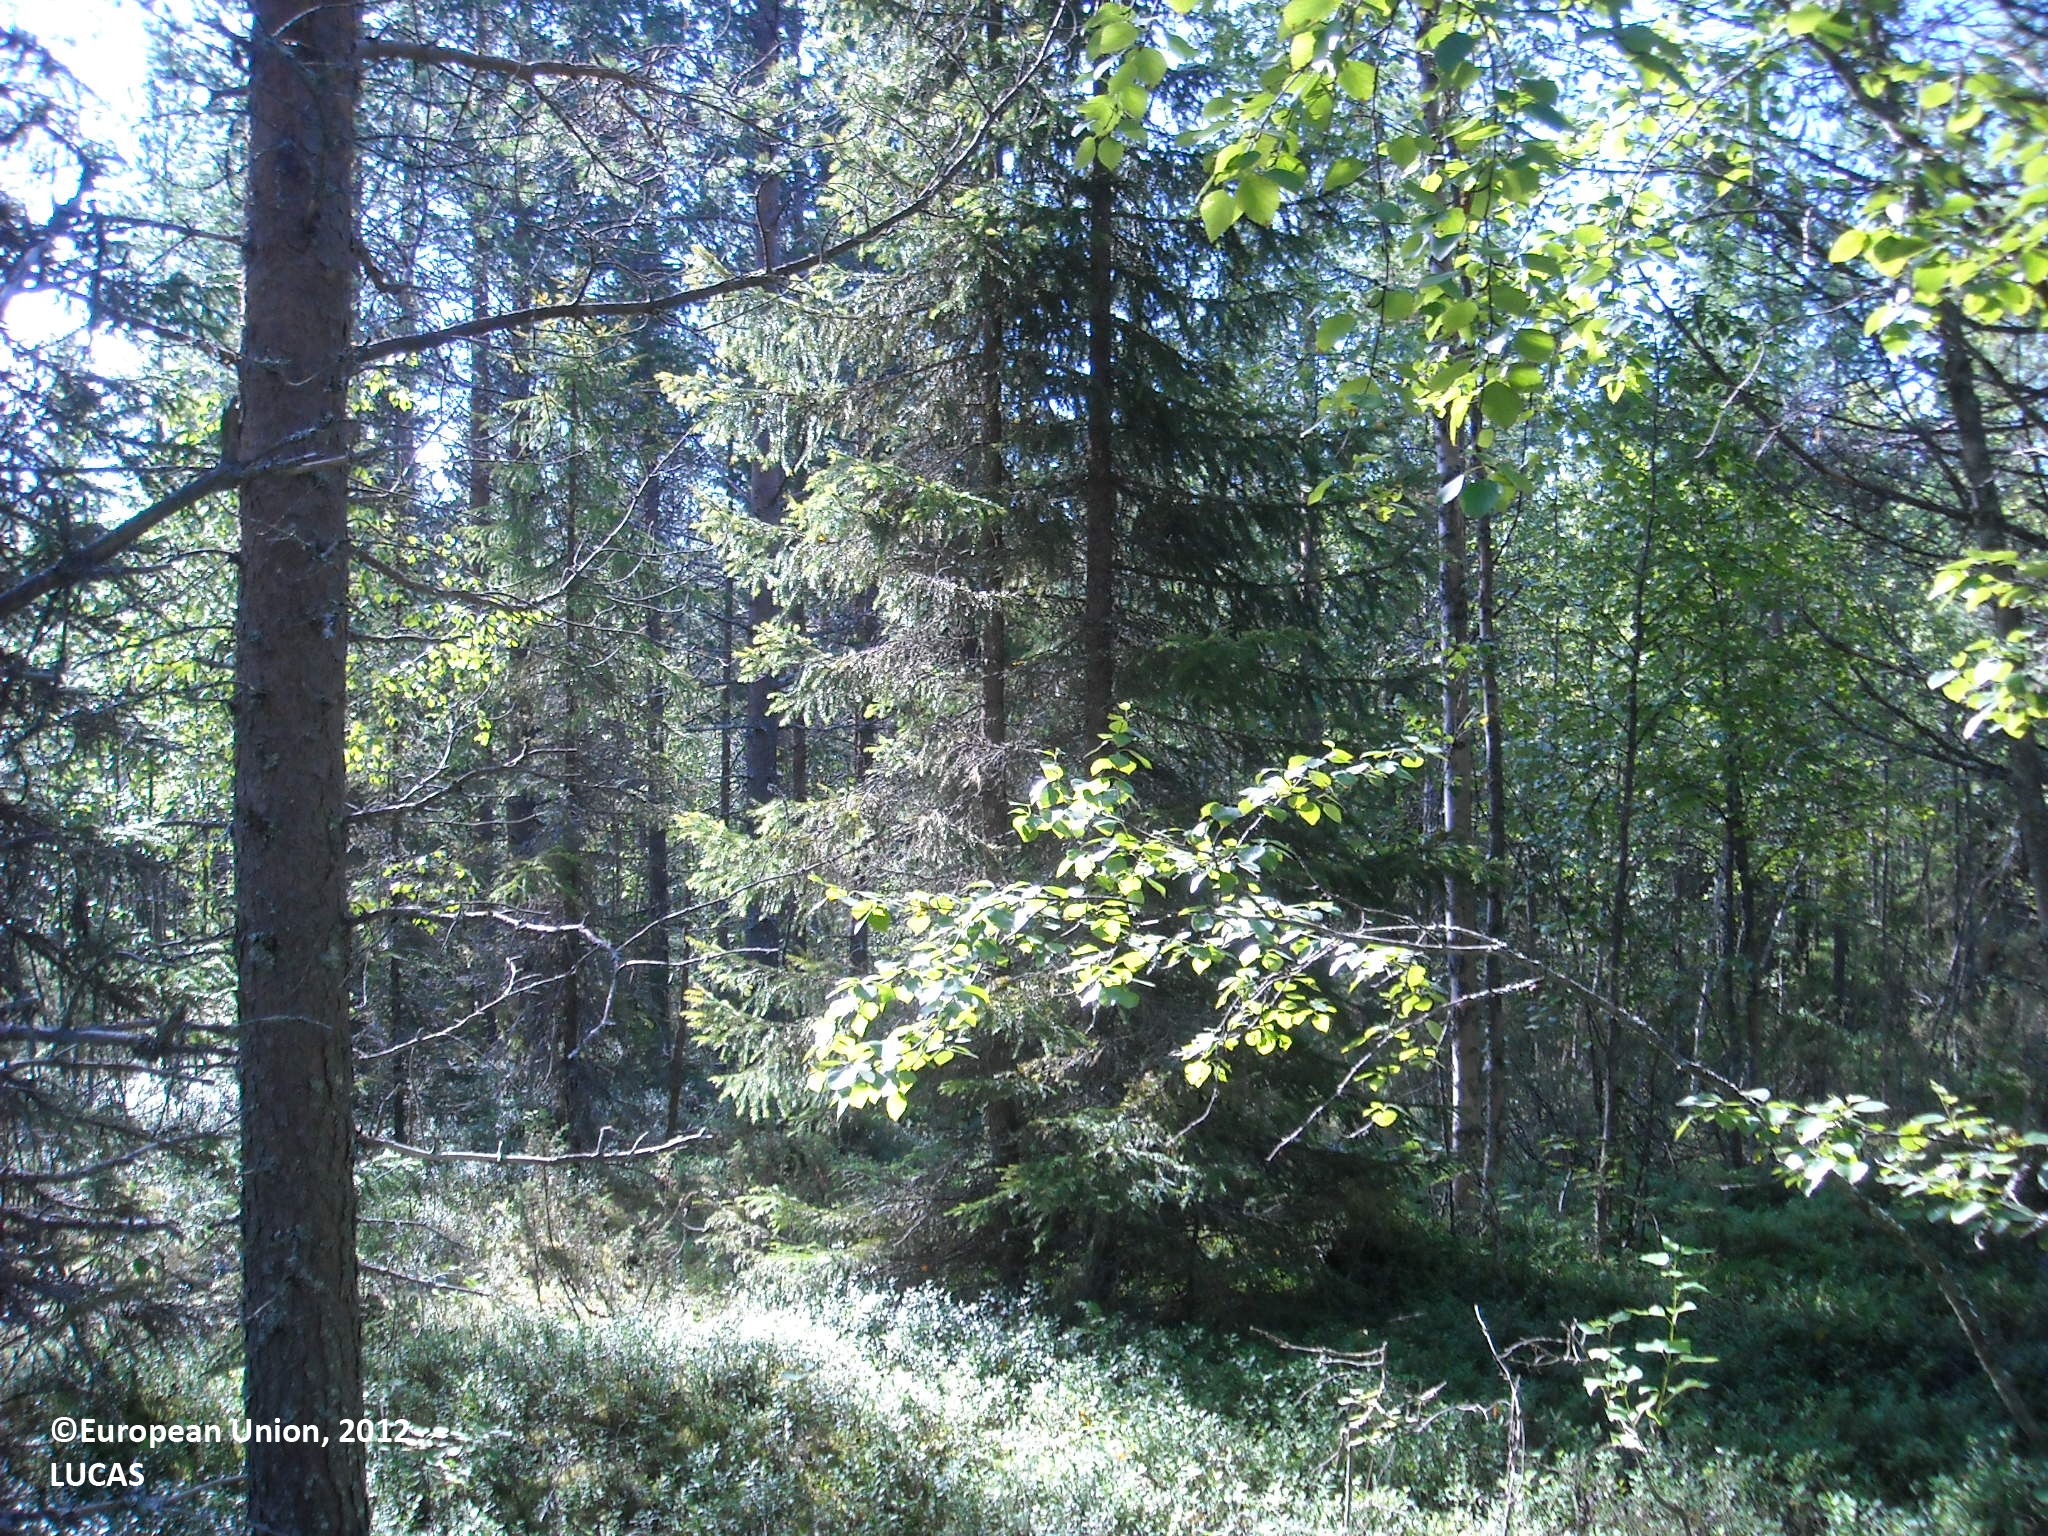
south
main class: Woodland
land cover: Other coniferous woodland
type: boreal forest
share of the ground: 50 - 75 %
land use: Forestry
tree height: > 5 m
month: August
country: FI
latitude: 65.1210
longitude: 27.7163
